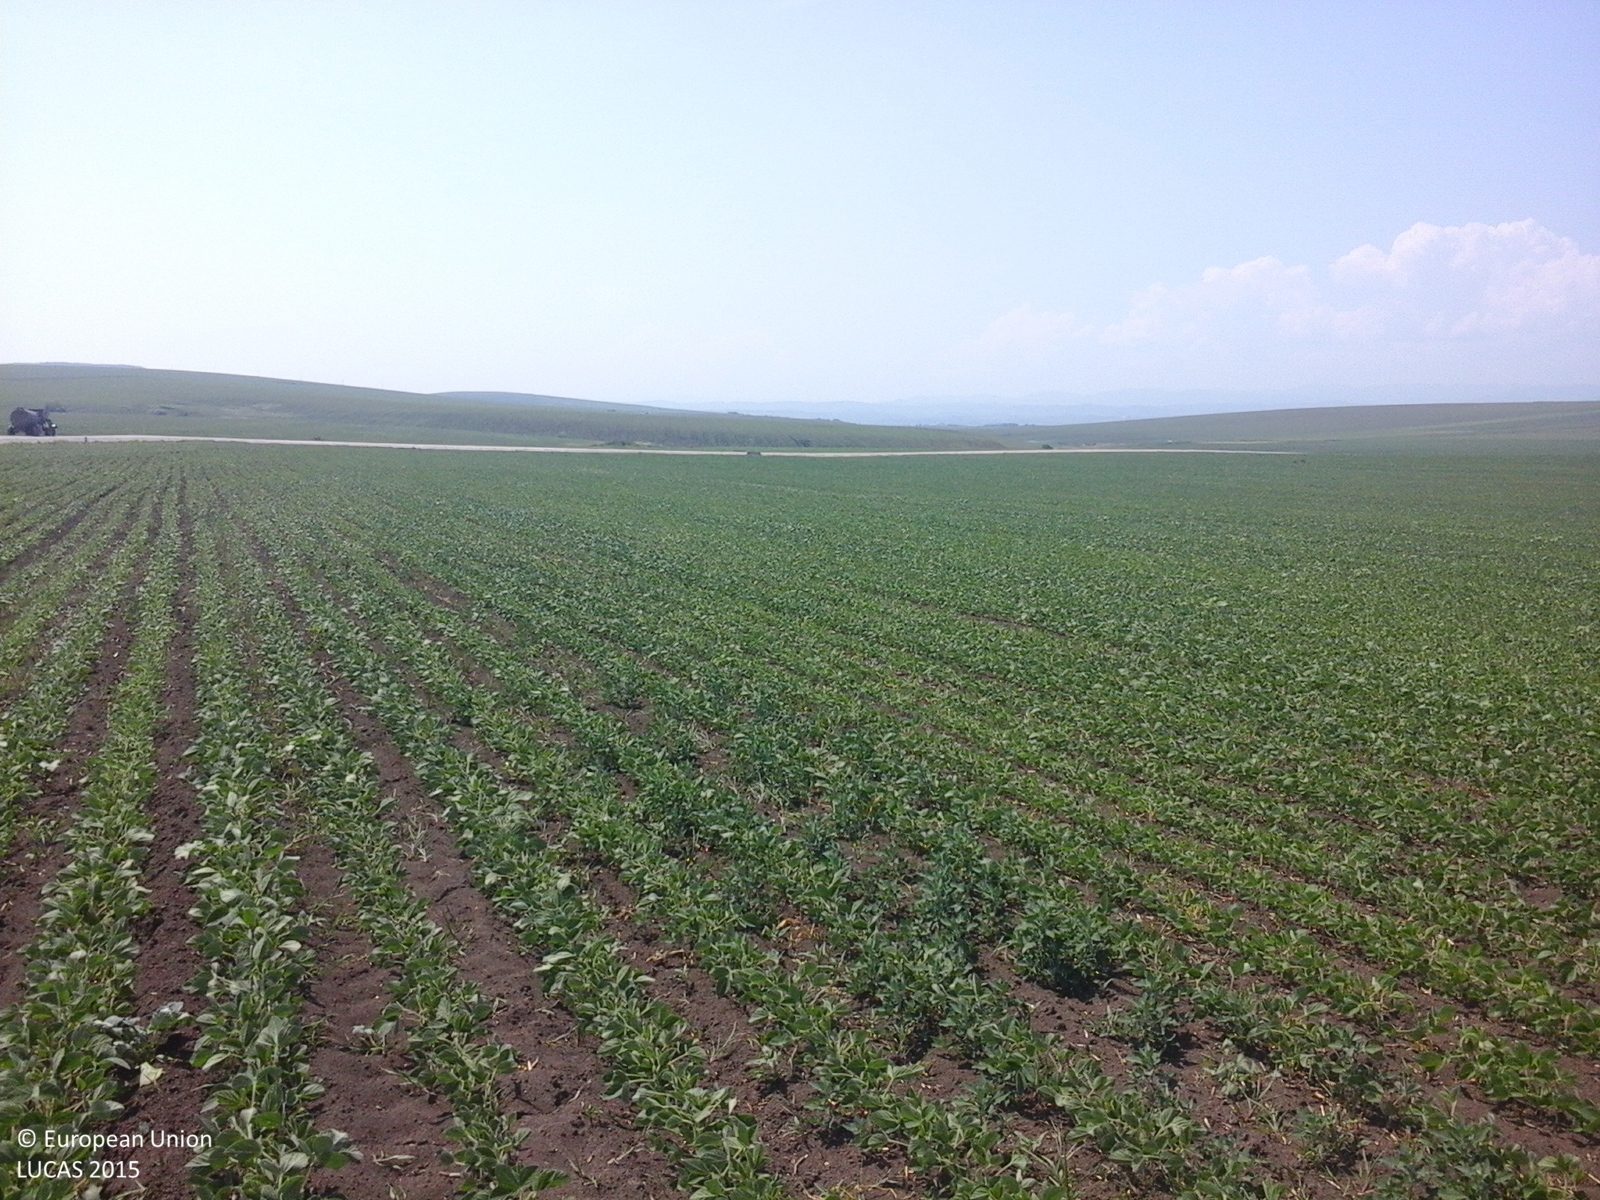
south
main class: Cropland
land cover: Soya
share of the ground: 50 - 75 %
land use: Agriculture (excluding fallow land and kitchen gardens)
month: June
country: RO
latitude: 46.8570
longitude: 26.6276
